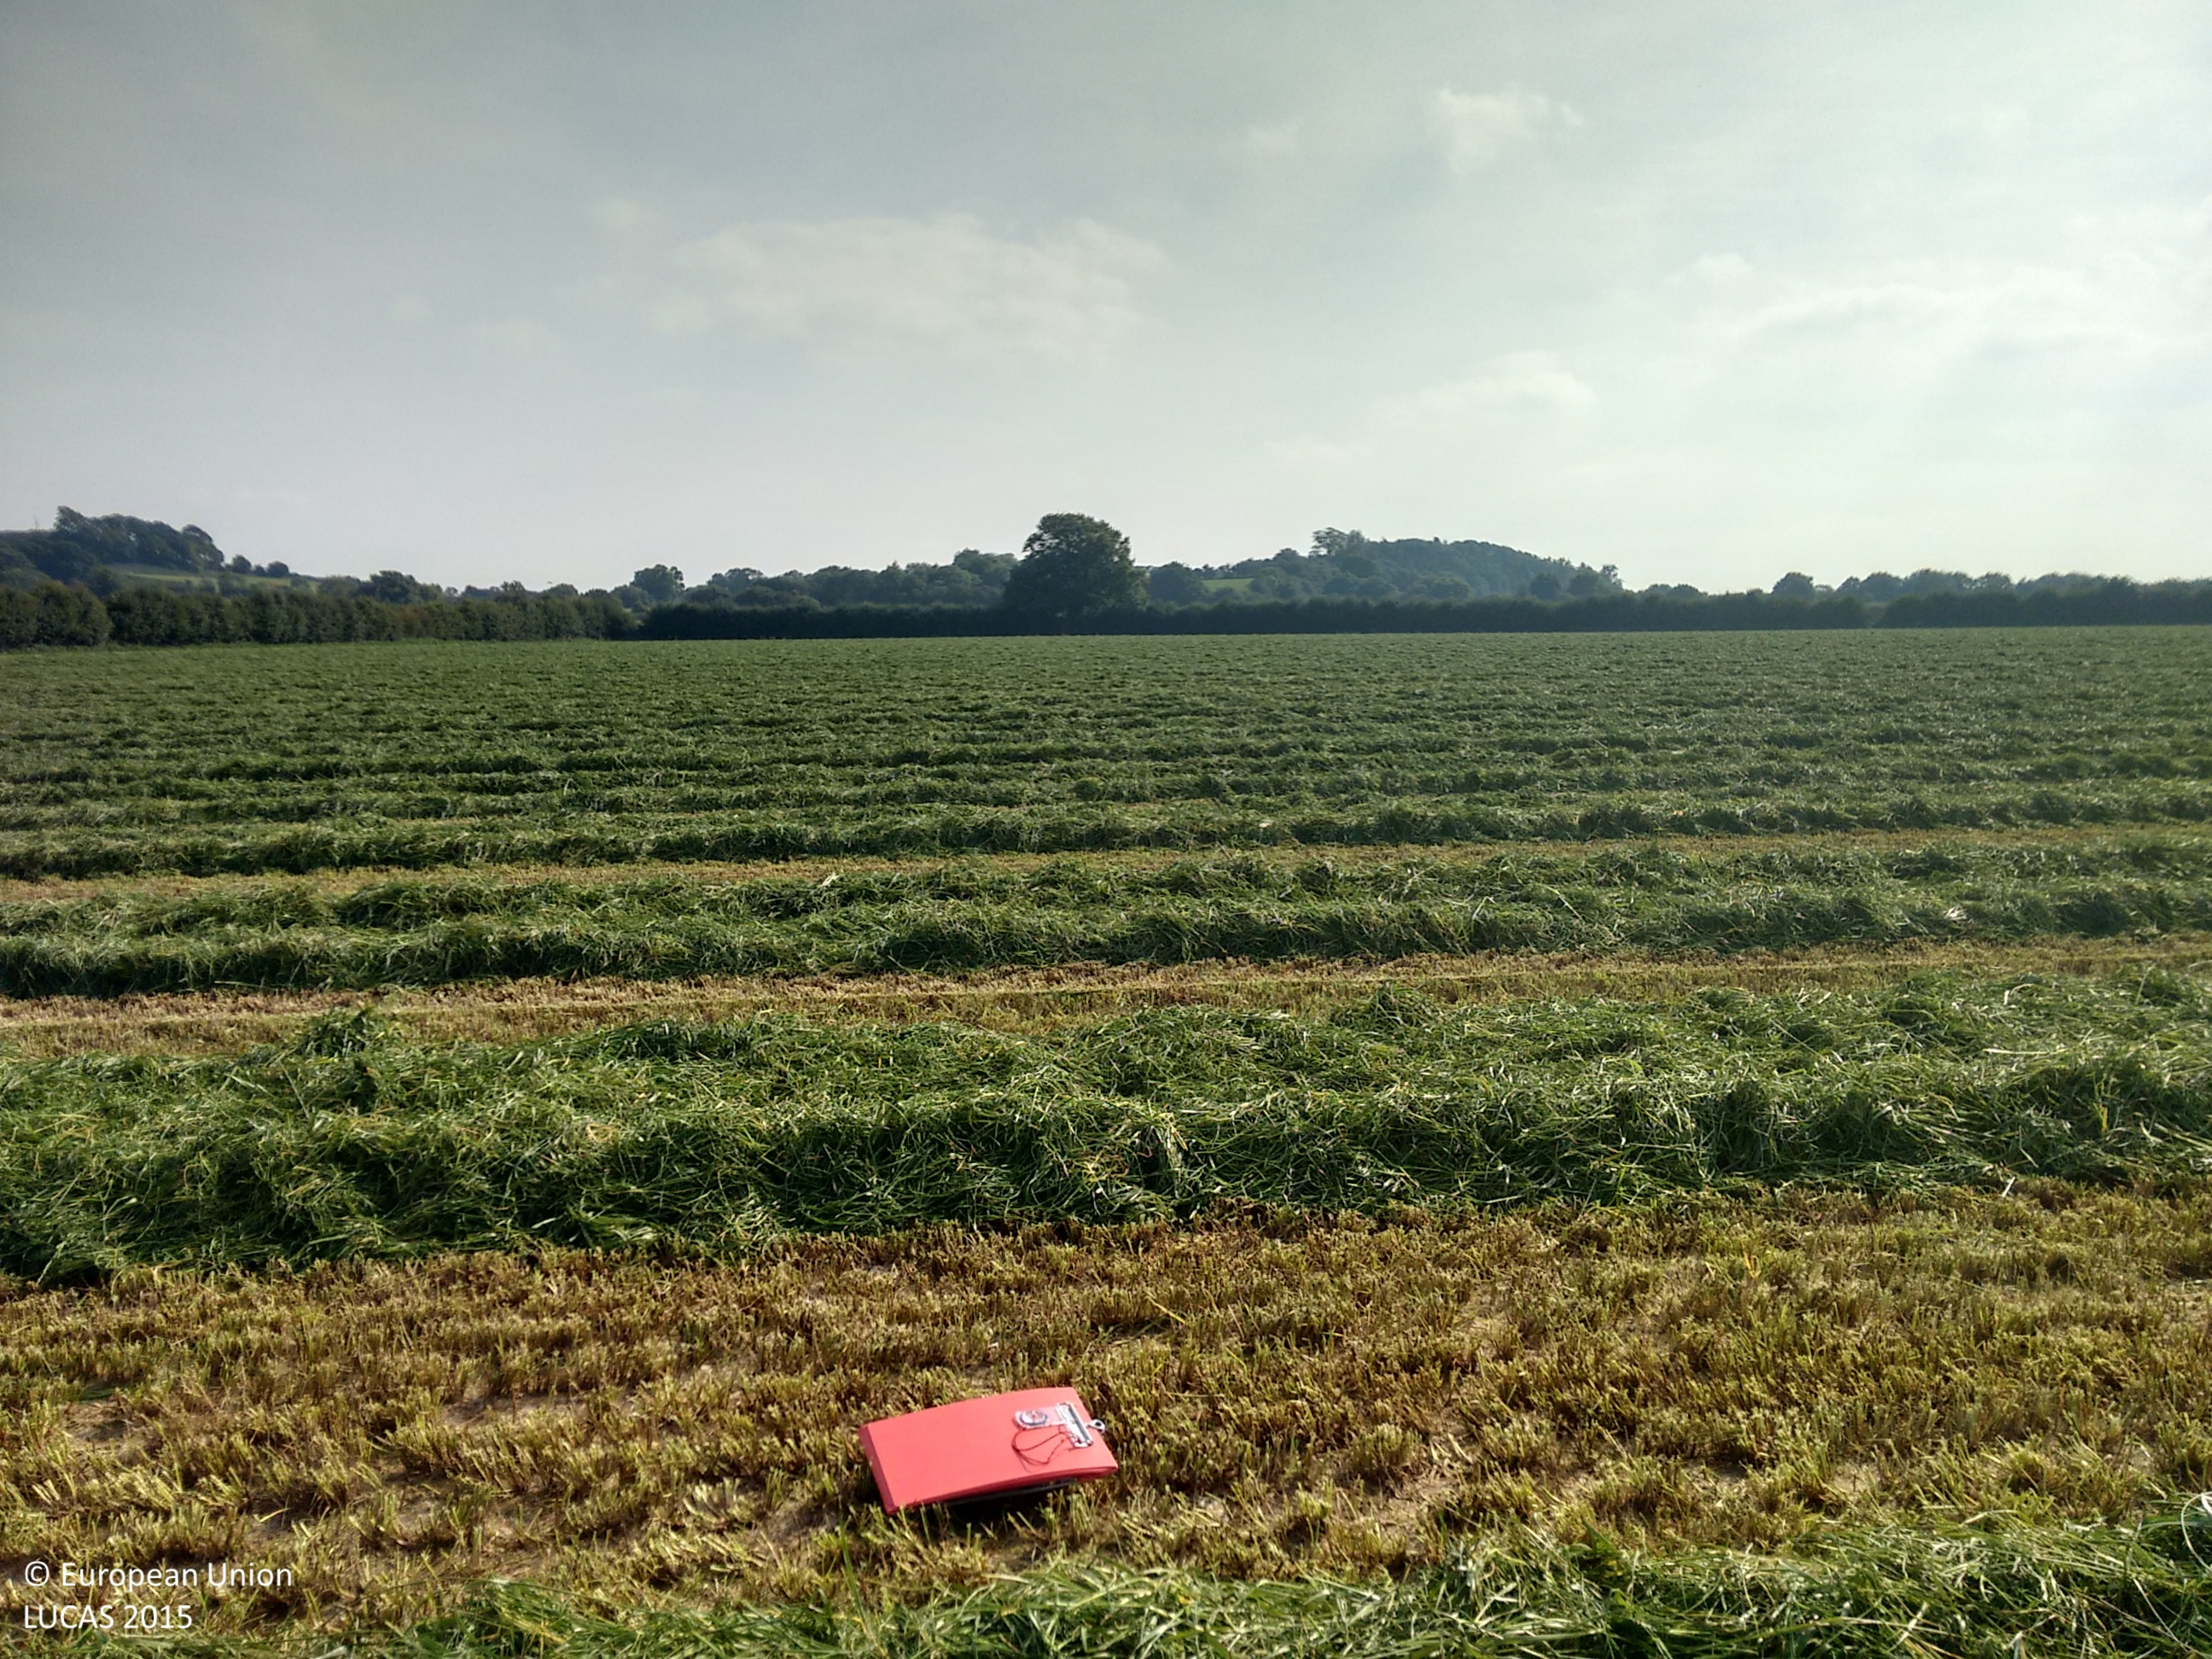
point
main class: Grassland
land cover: Grassland without tree/shrub cover
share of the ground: > 75 %
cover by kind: herbaceous plants 100 %
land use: Agriculture (excluding fallow land and kitchen gardens)
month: September
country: GB
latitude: 52.7698
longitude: -2.3208
